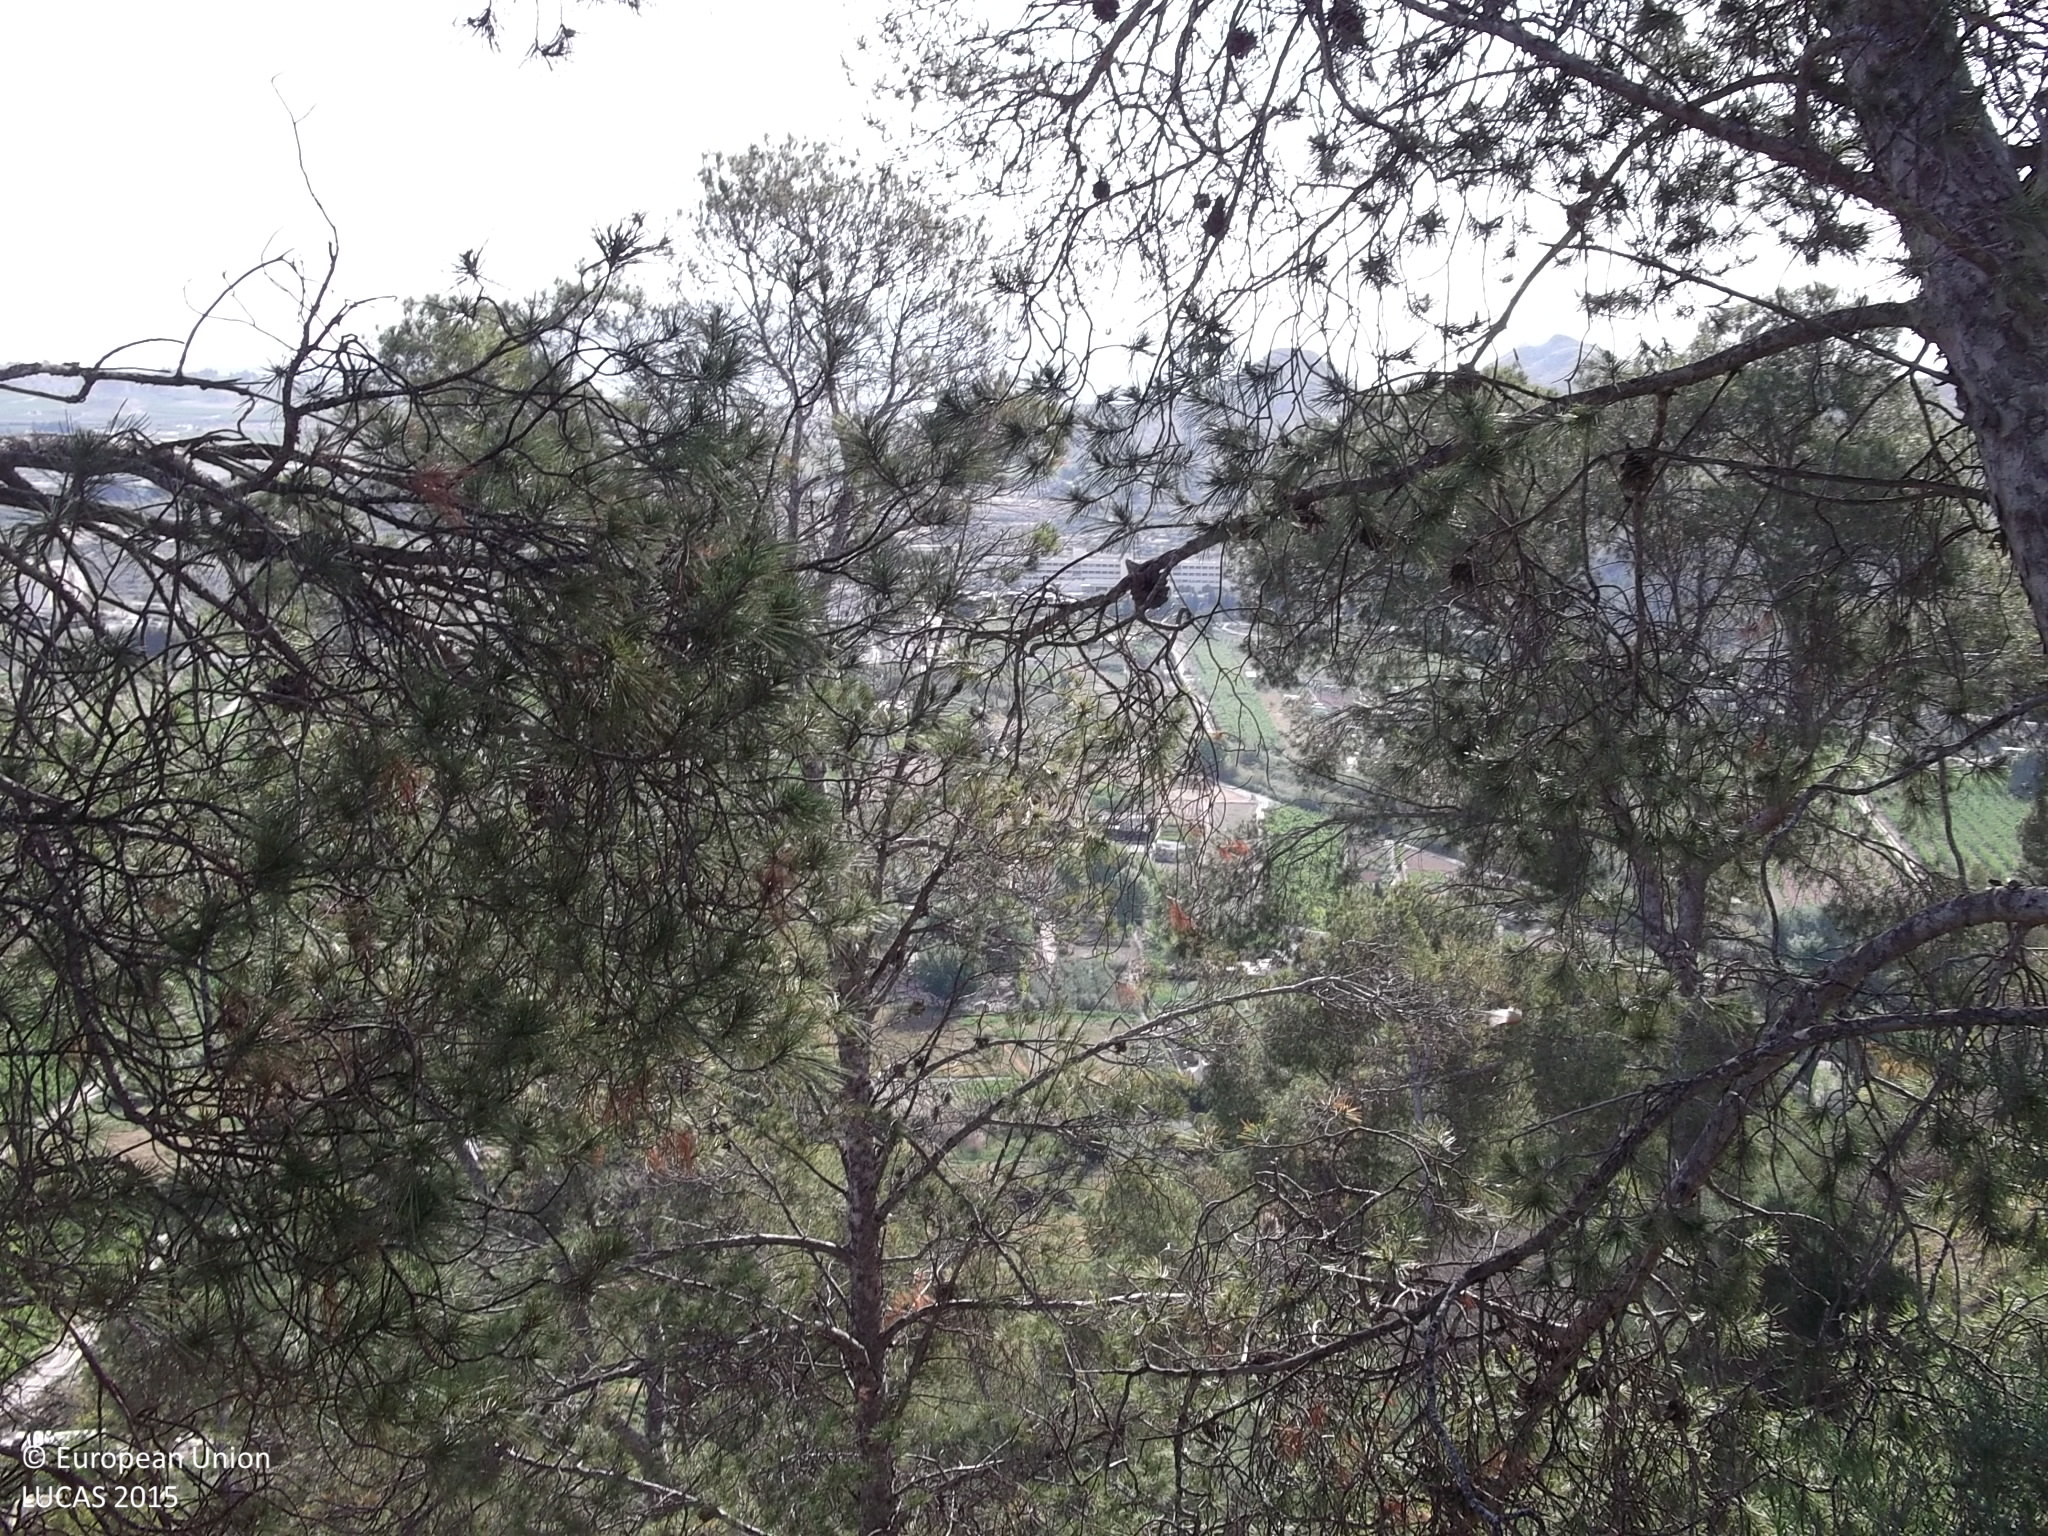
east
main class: Woodland
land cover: Pine dominated coniferous woodland
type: coniferous forest of the mediterranean region
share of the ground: 10 - 25 %
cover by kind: shrubs 65 %, herbaceous plants 20 %, coniferous forest trees 15 %
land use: Semi-natural and natural areas not in use
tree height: > 5 m
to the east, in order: Pine dominated coniferous woodland; Electric lines; Pine dominated coniferous woodland; Tracks; Grass margins; Spontaneously vegetated surfaces; Grass margins; Spontaneously vegetated surfaces; Grass margins; Fences; Broadleaved woodland
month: April
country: ES
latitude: 38.2276
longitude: -1.4231
